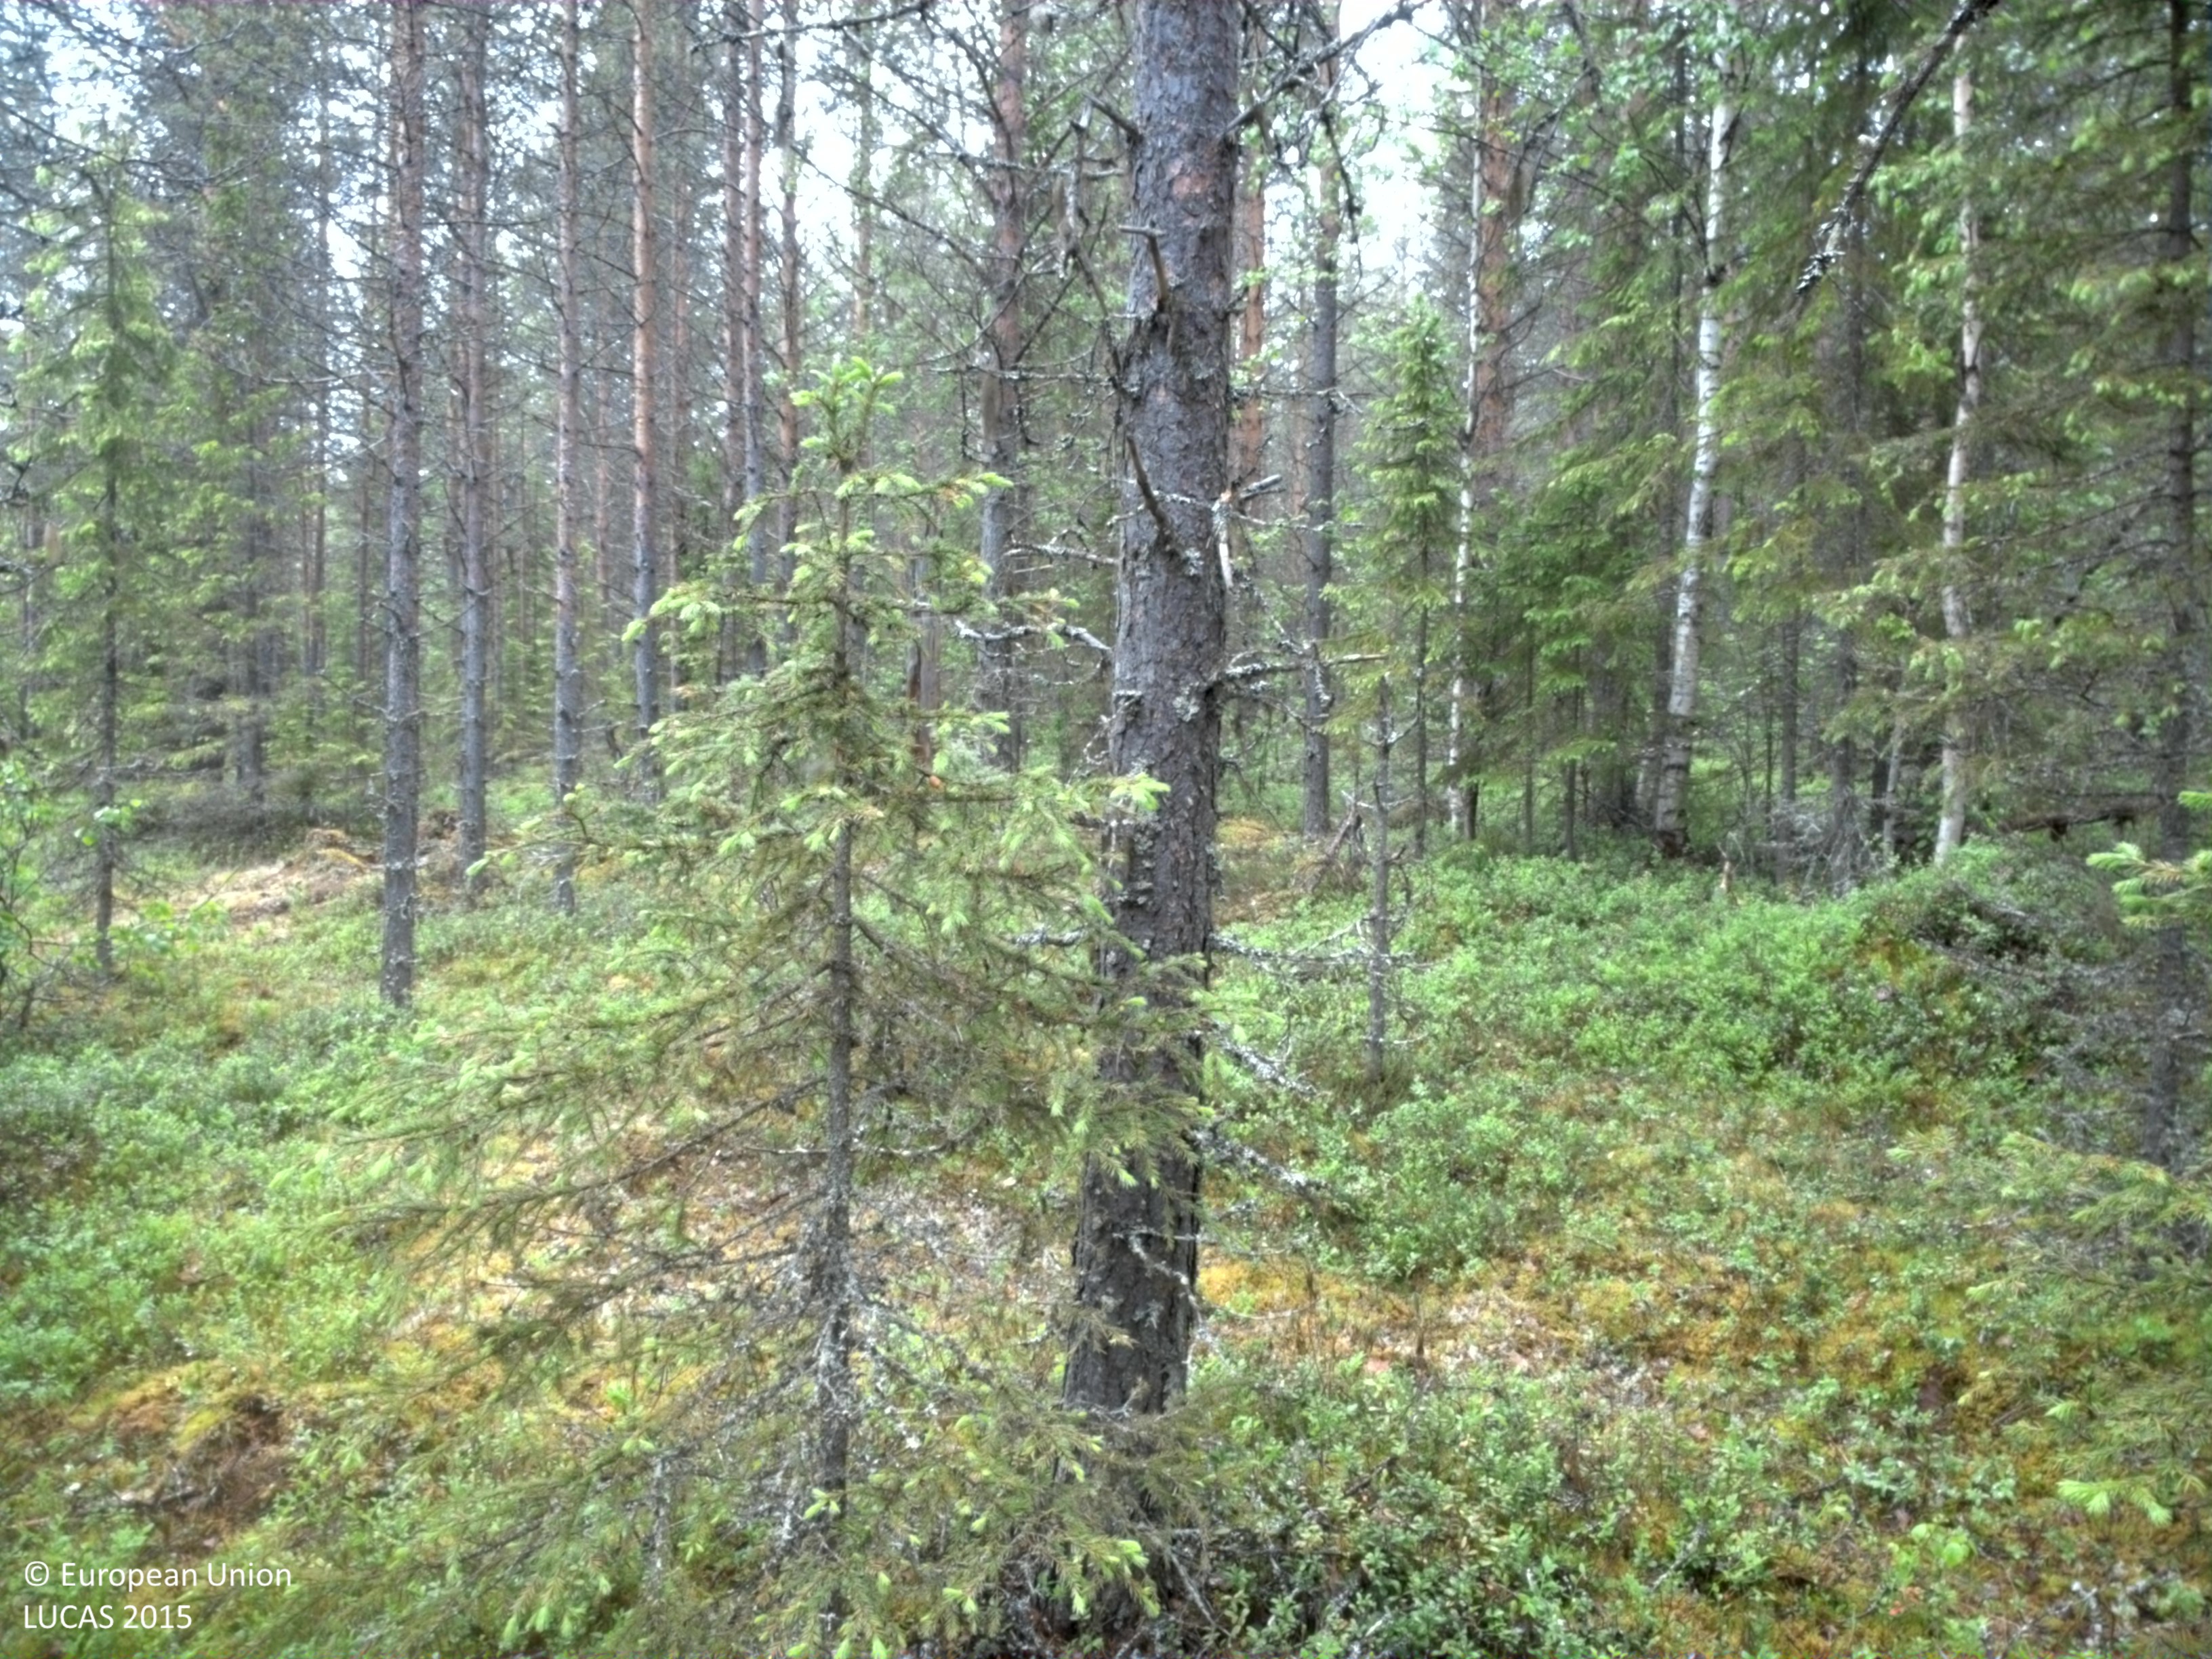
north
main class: Woodland
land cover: Pine dominated coniferous woodland
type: boreal forest
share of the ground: 25 - 50 %
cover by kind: shrubs 50 %, coniferous forest trees 40 %, broadleaved forest trees 5 %, lichens and mosses 5 %
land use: Forestry
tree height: > 5 m
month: June
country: SE
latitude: 66.5355
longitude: 22.8714
